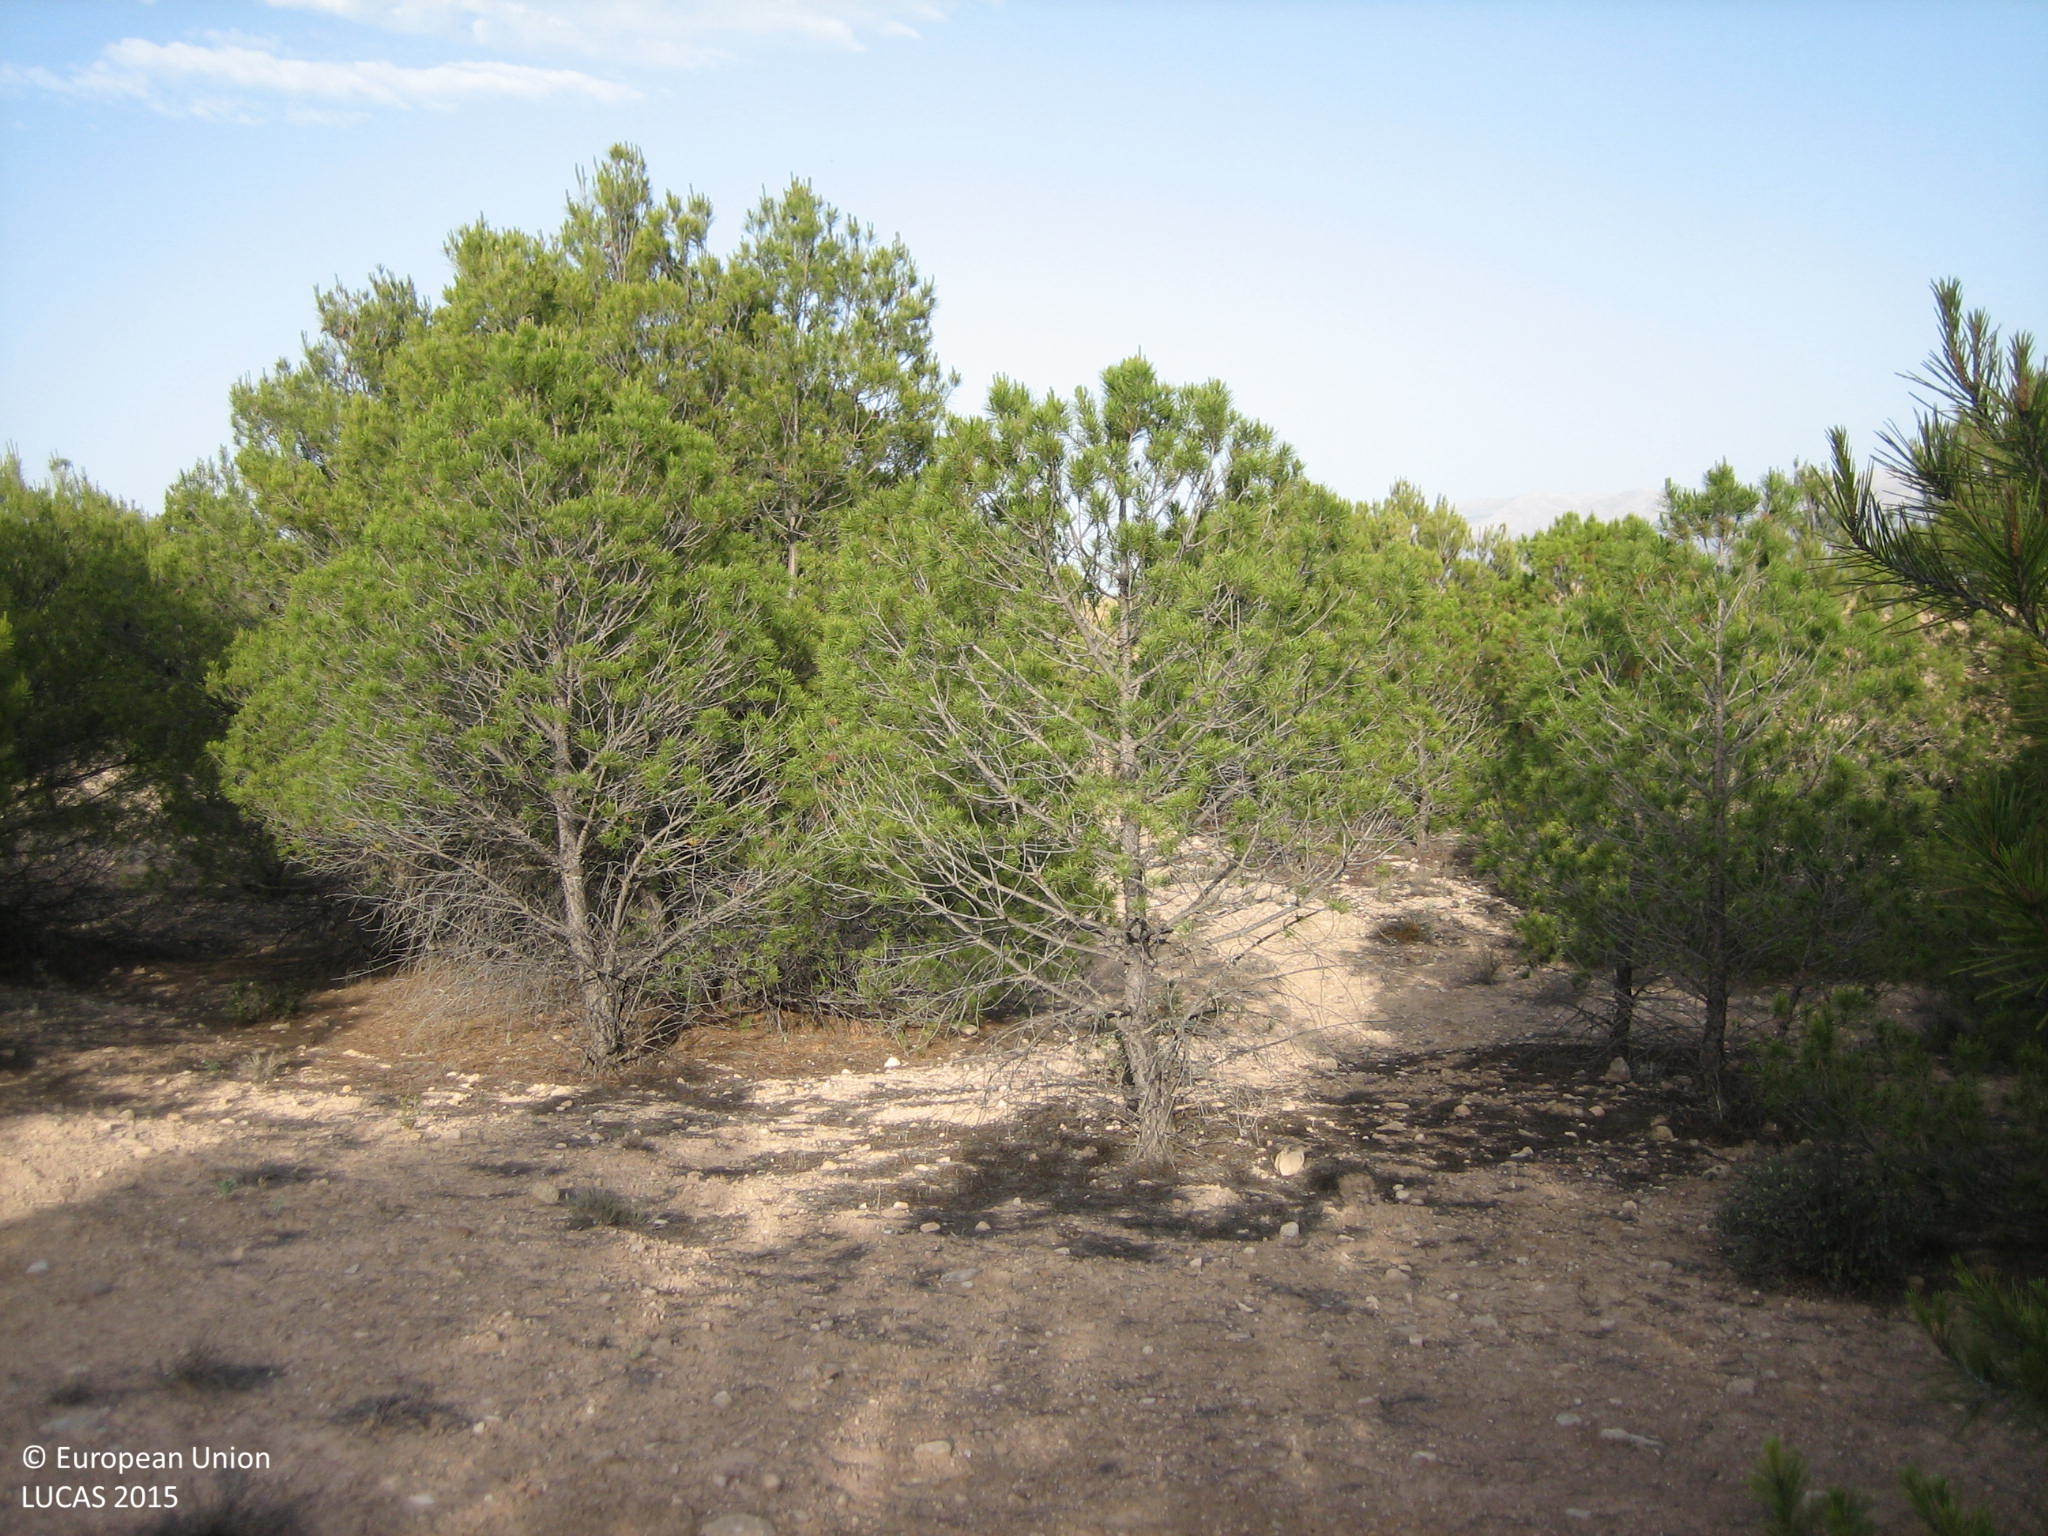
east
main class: Woodland
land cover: Pine dominated coniferous woodland
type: coniferous forest of the mediterranean region
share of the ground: > 75 %
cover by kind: coniferous forest trees 80 %, unconsolidated bare surface 20 %
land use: Forestry
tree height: < 5 m
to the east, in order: Pine dominated coniferous woodland; Tracks; Grassland without tree/shrub cover; Rivers and streams; Barley; Grass margins; Other bare soil
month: July
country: ES
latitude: 37.7429
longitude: -2.3688
